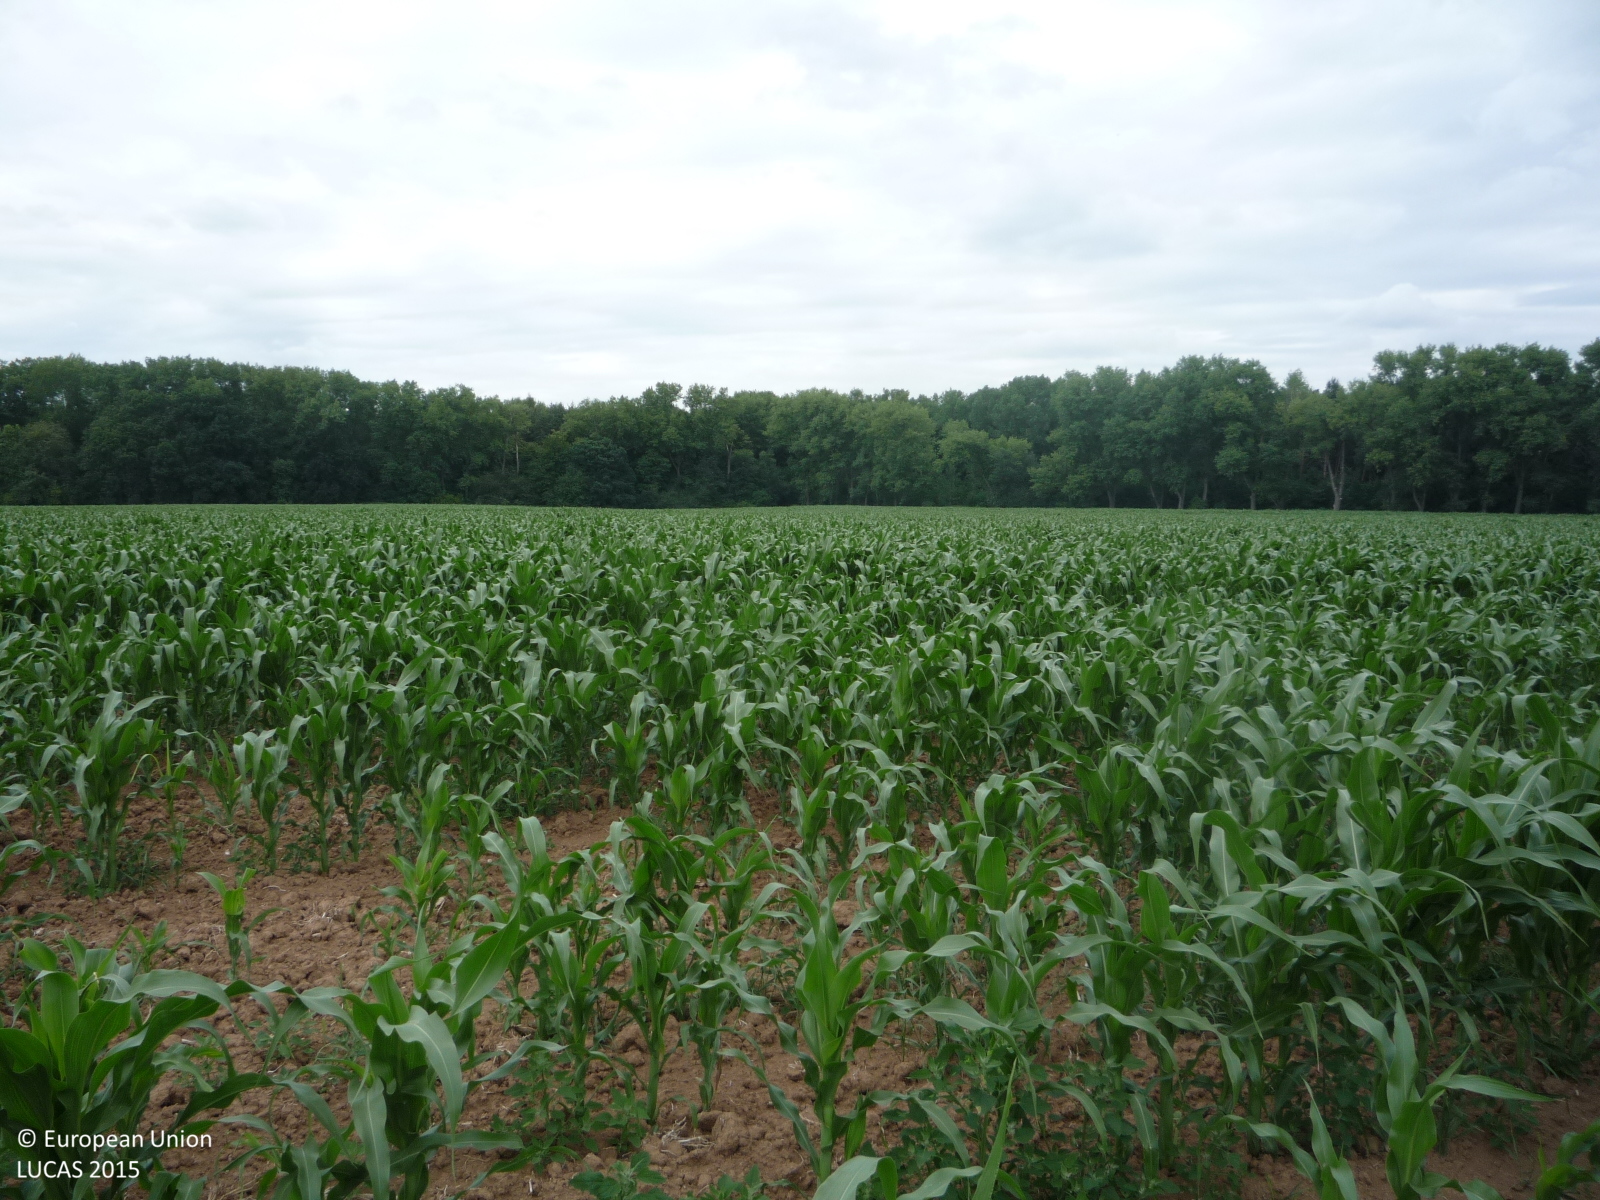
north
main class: Cropland
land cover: Maize
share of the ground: > 75 %
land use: Agriculture (excluding fallow land and kitchen gardens)
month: June
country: CZ
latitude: 50.0675
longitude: 15.1583
